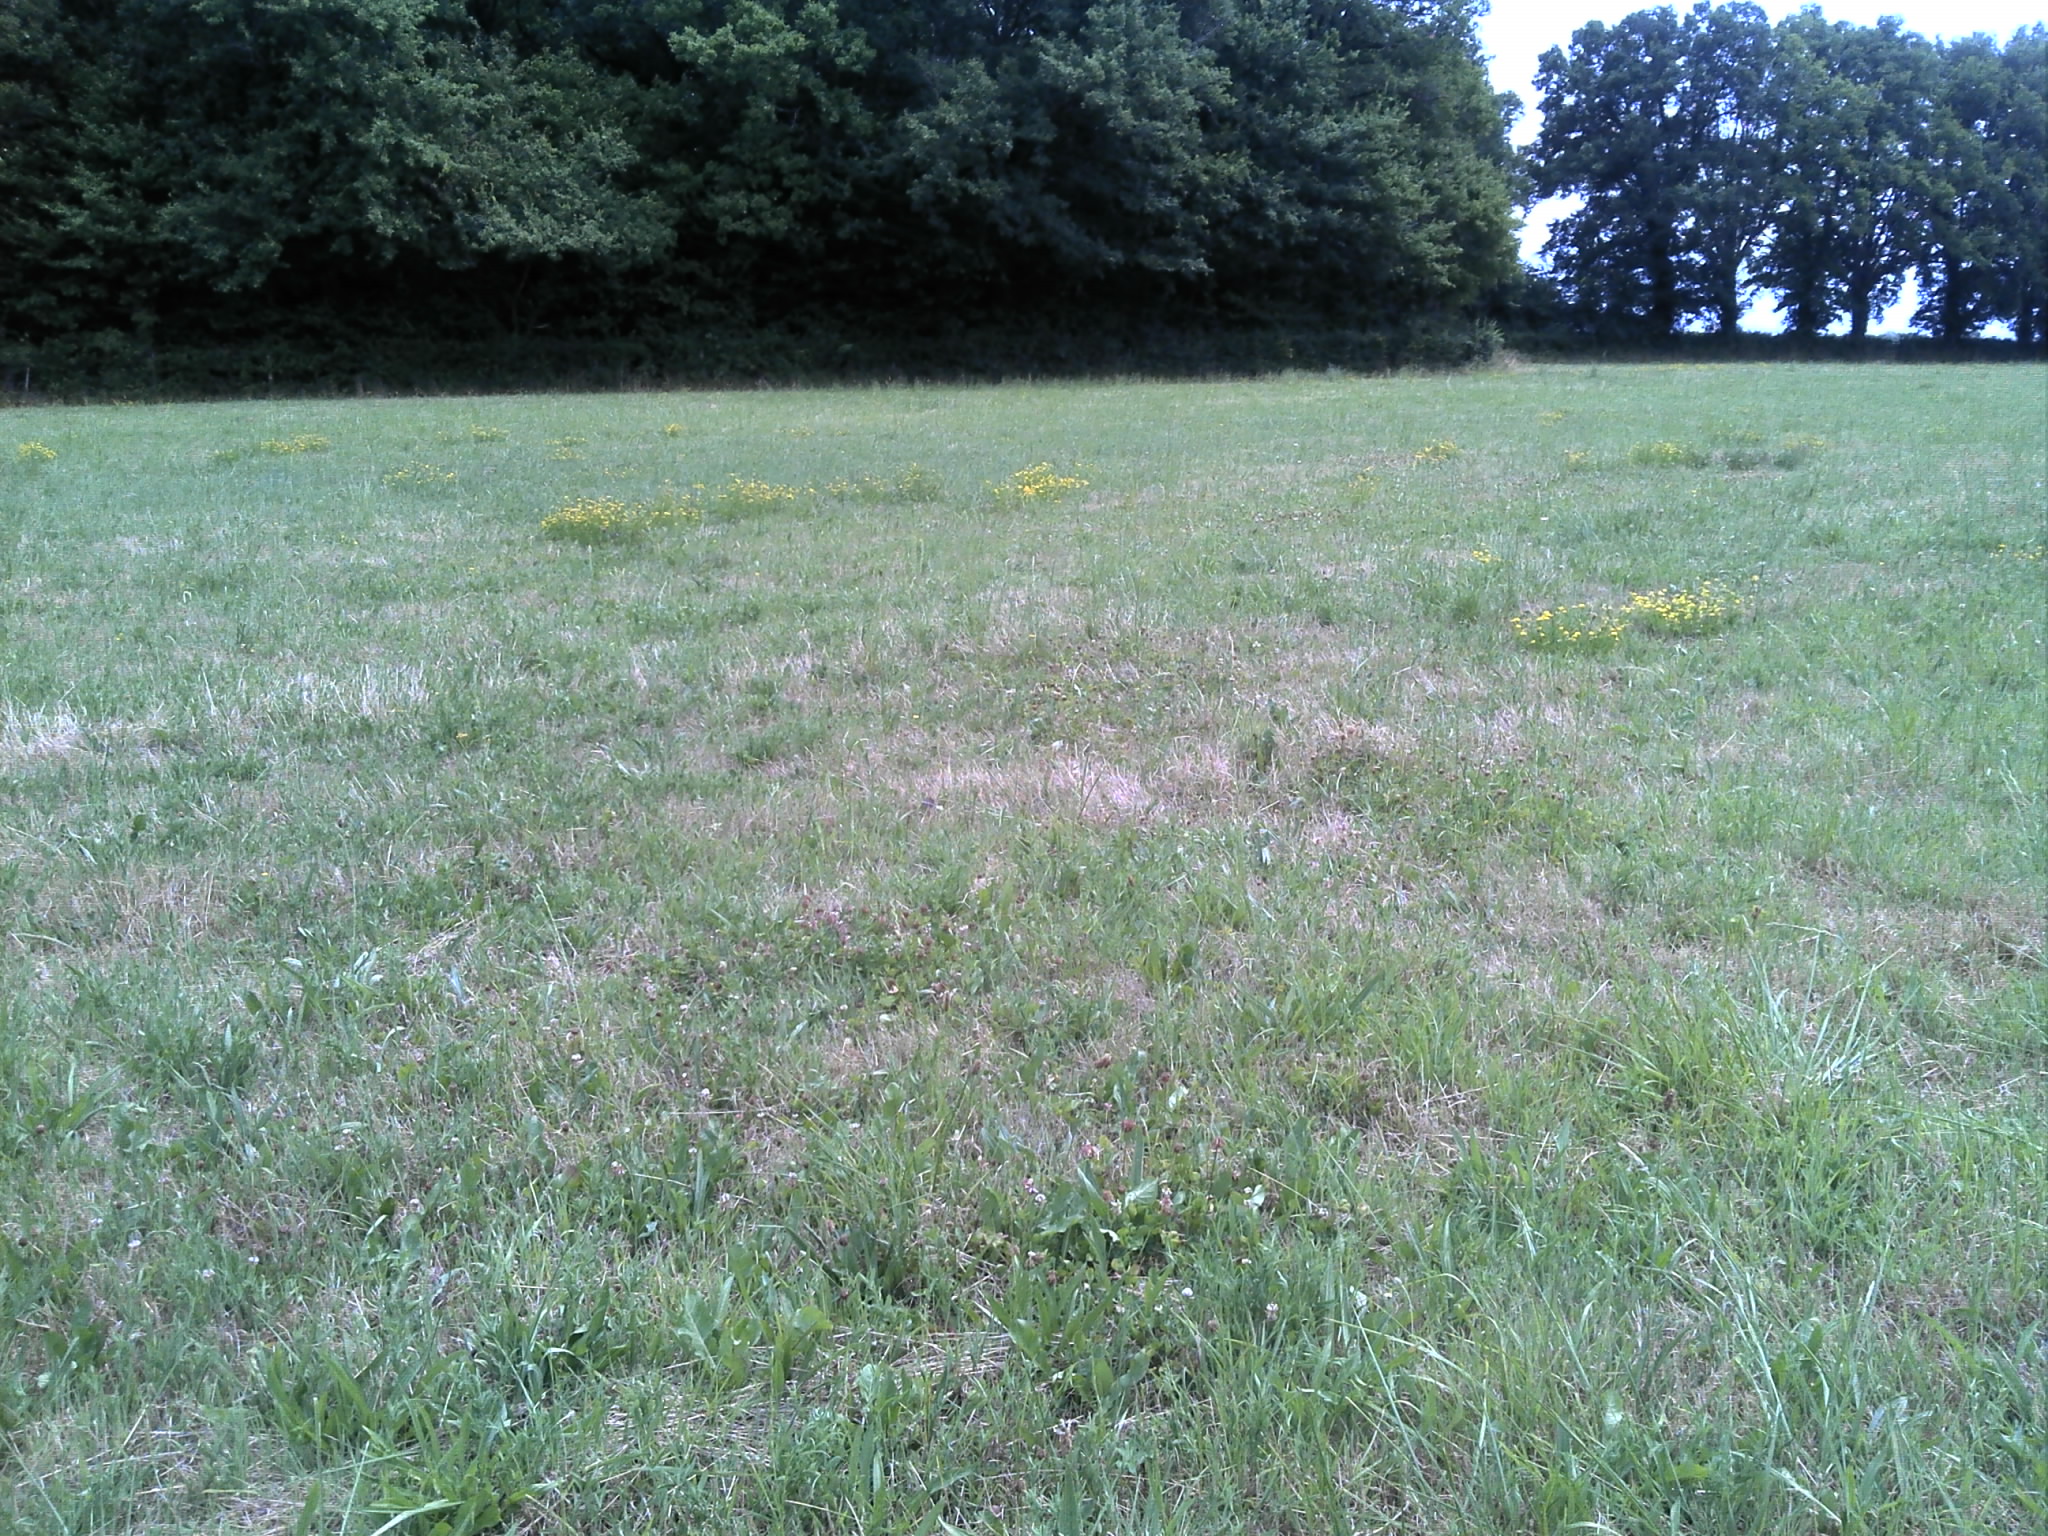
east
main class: Grassland
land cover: Grassland without tree/shrub cover
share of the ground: > 75 %
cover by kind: herbaceous plants 100 %
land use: Agriculture (excluding fallow land and kitchen gardens)
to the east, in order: Grassland without tree/shrub cover; Fences; Broadleaved woodland; Ditches and canals; Broadleaved woodland; Ditches and canals; Broadleaved woodland
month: July
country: FR
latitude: 46.7184
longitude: 1.4982
